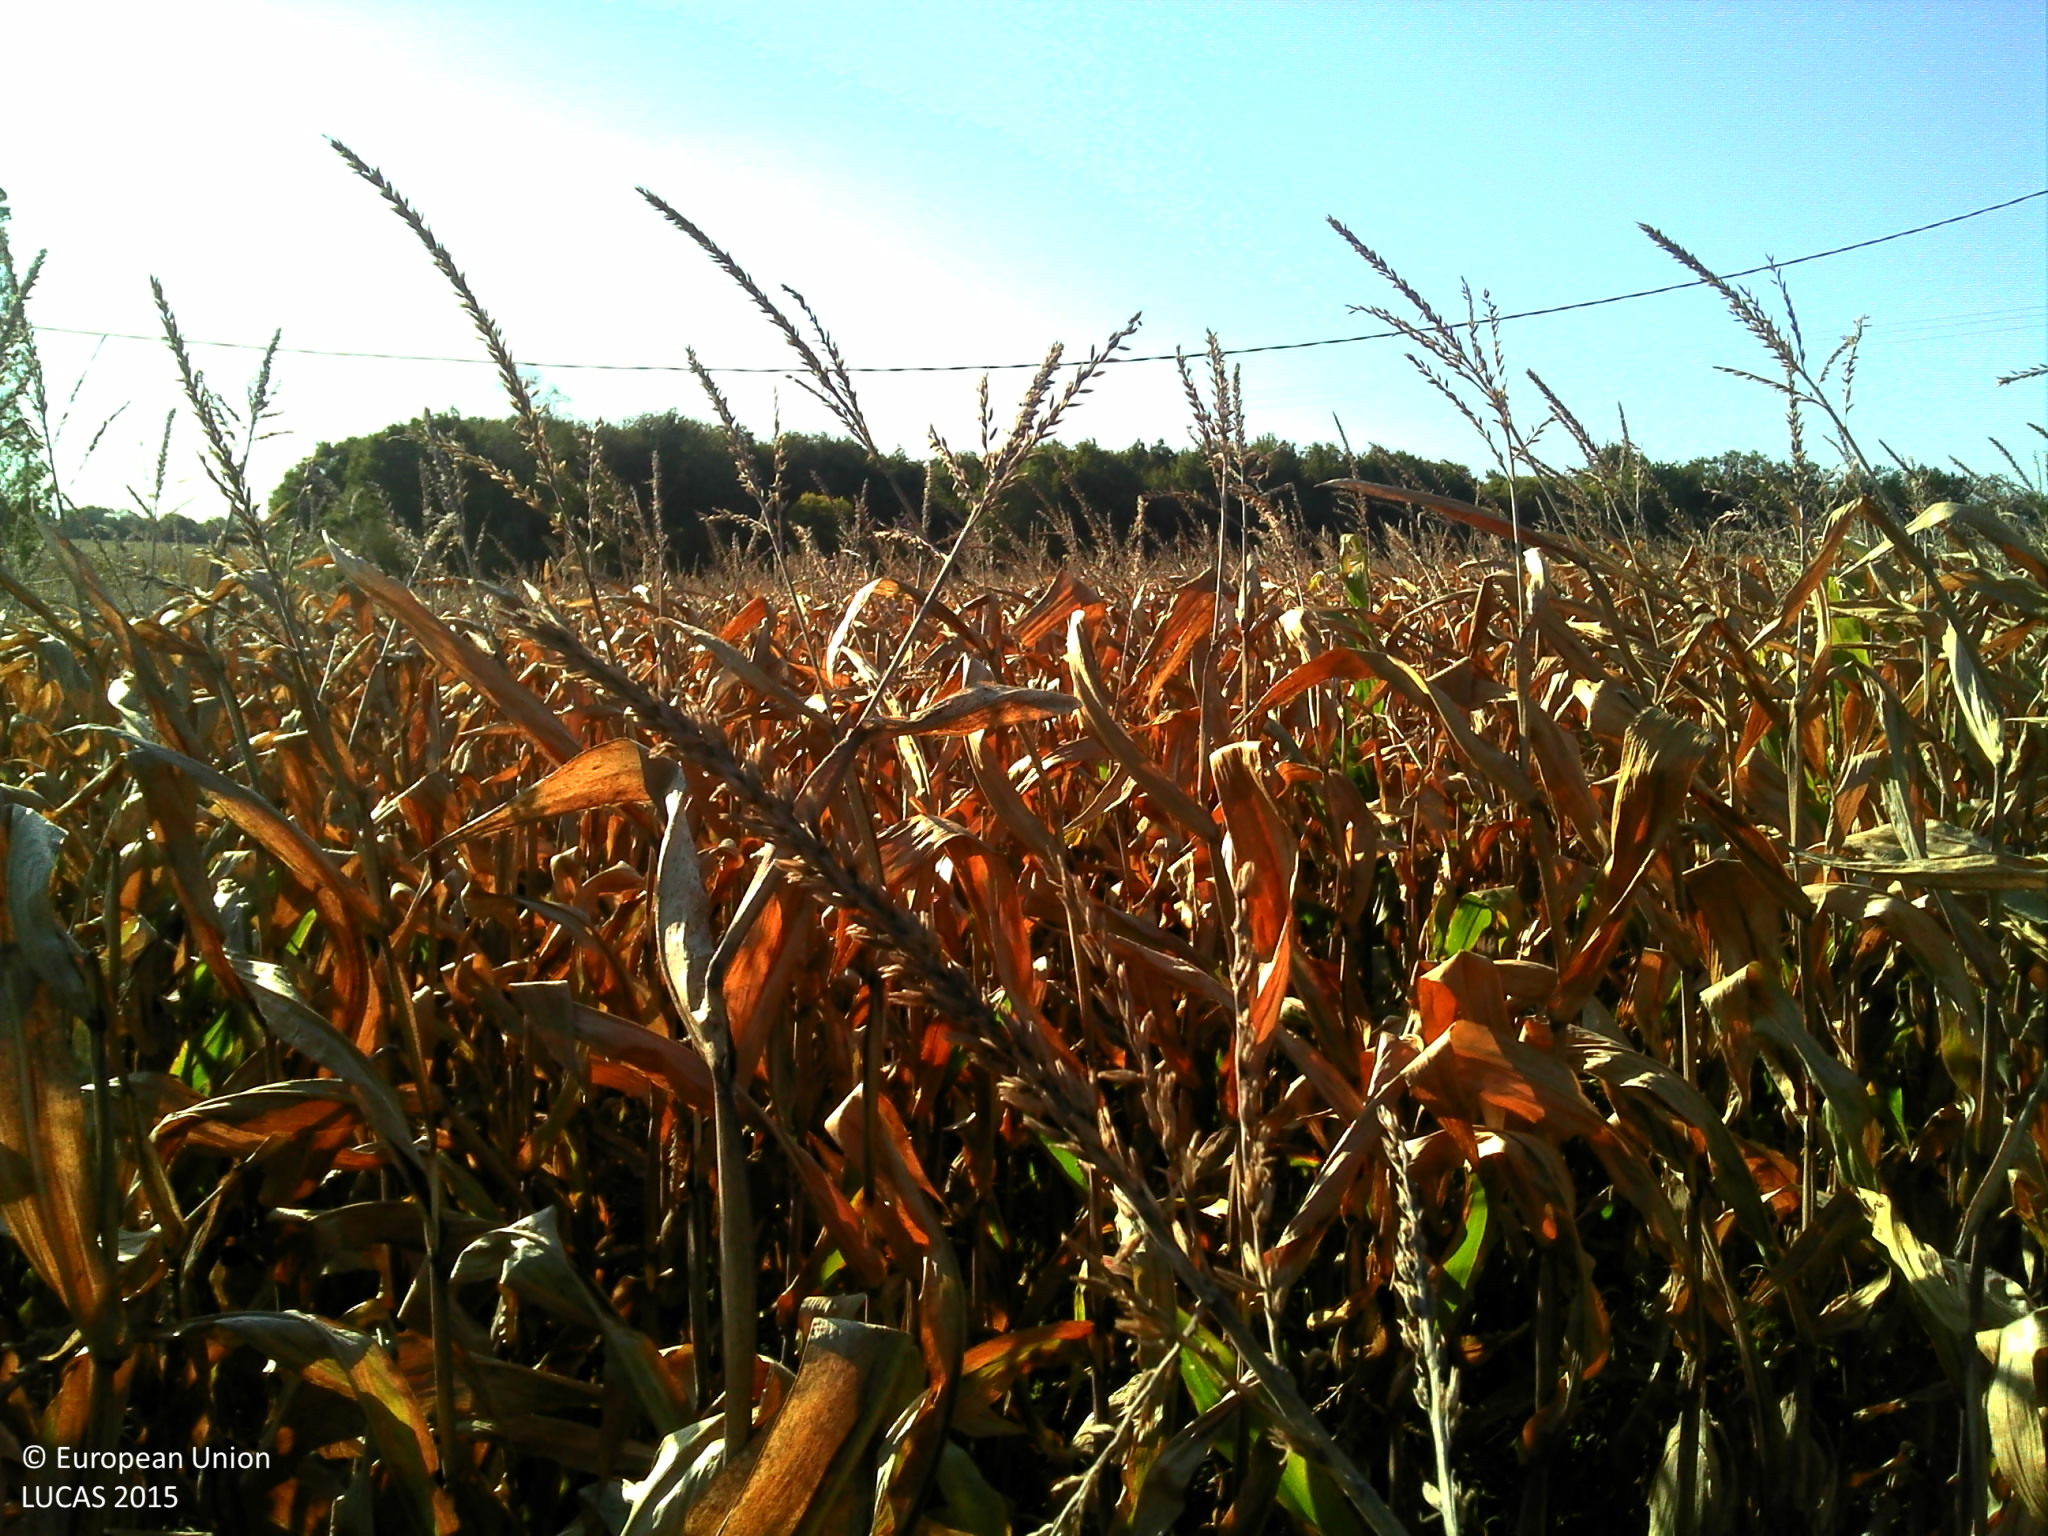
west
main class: Cropland
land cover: Maize
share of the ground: 50 - 75 %
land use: Agriculture (excluding fallow land and kitchen gardens)
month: September
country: FR
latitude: 46.5674
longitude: -1.1362
